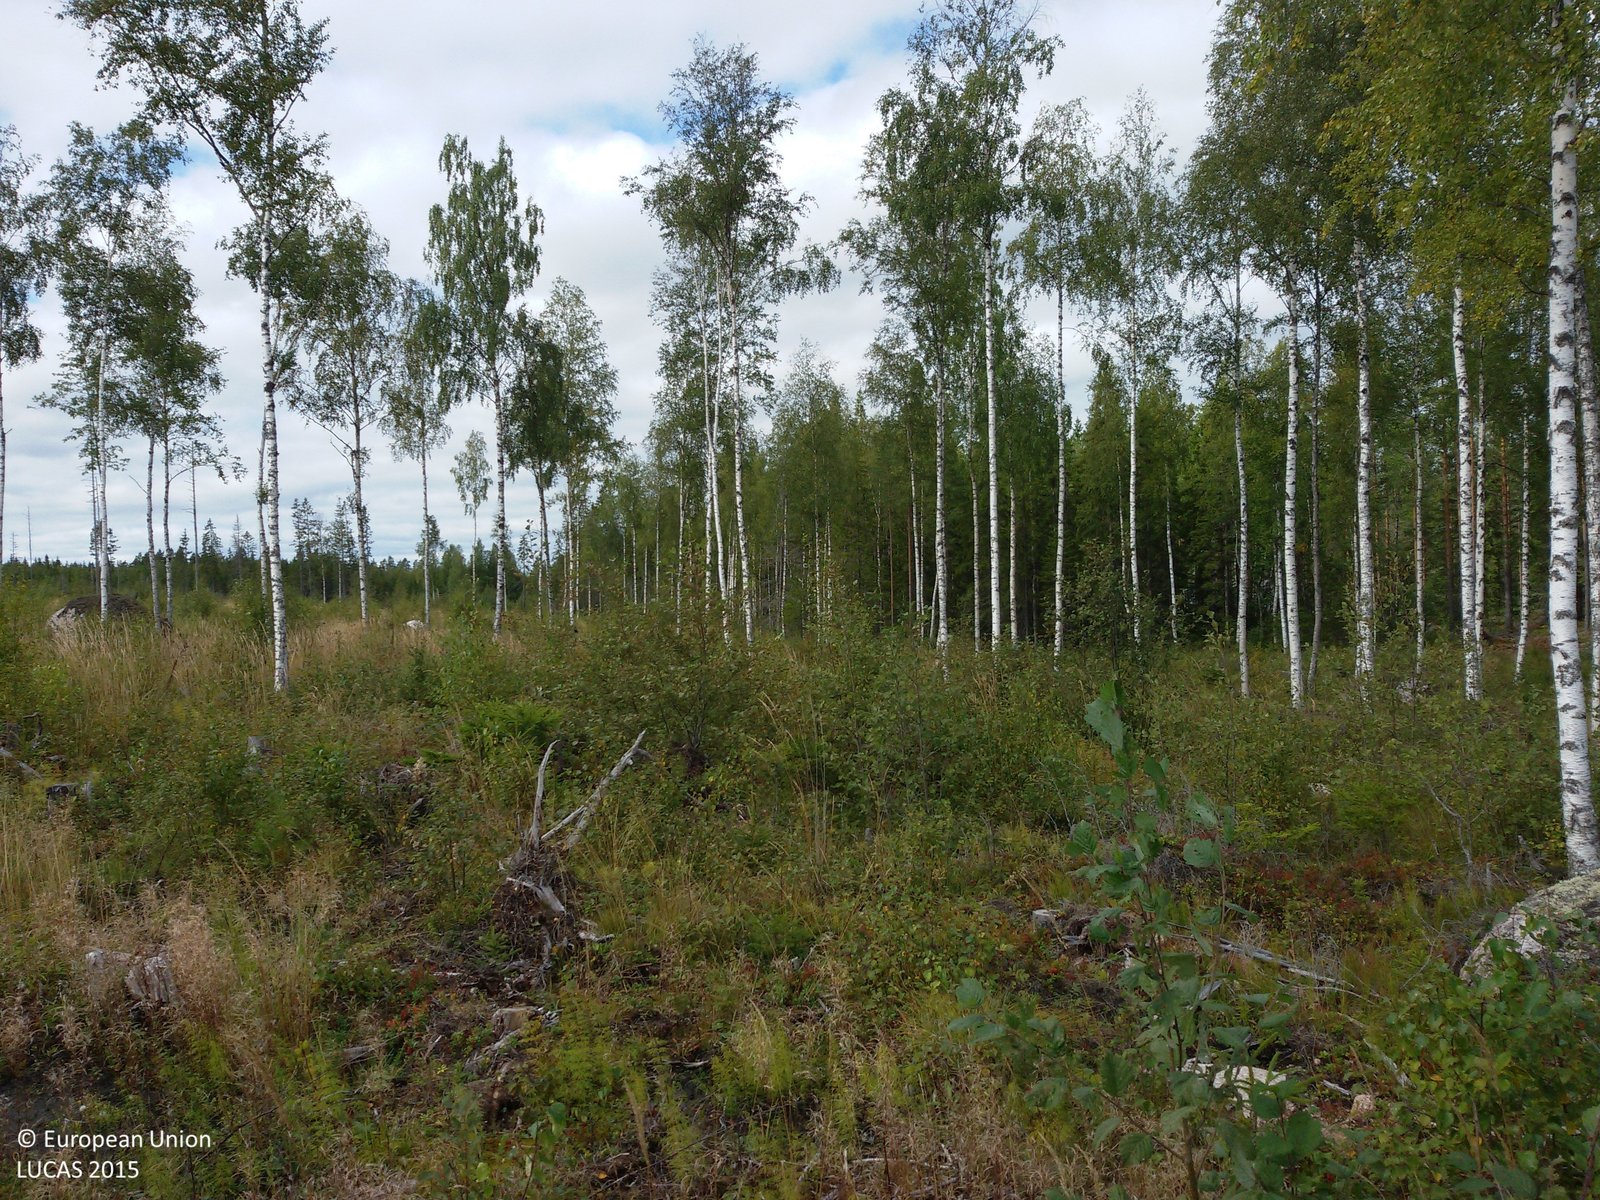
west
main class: Woodland
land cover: Broadleaved woodland
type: boreal forest
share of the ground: 50 - 75 %
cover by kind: broadleaved forest trees 50 %, herbaceous plants 35 %, lichens and mosses 10 %, coniferous forest trees 5 %
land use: Forestry
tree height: < 5 m
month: September
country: SE
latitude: 60.9799
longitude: 15.4004
